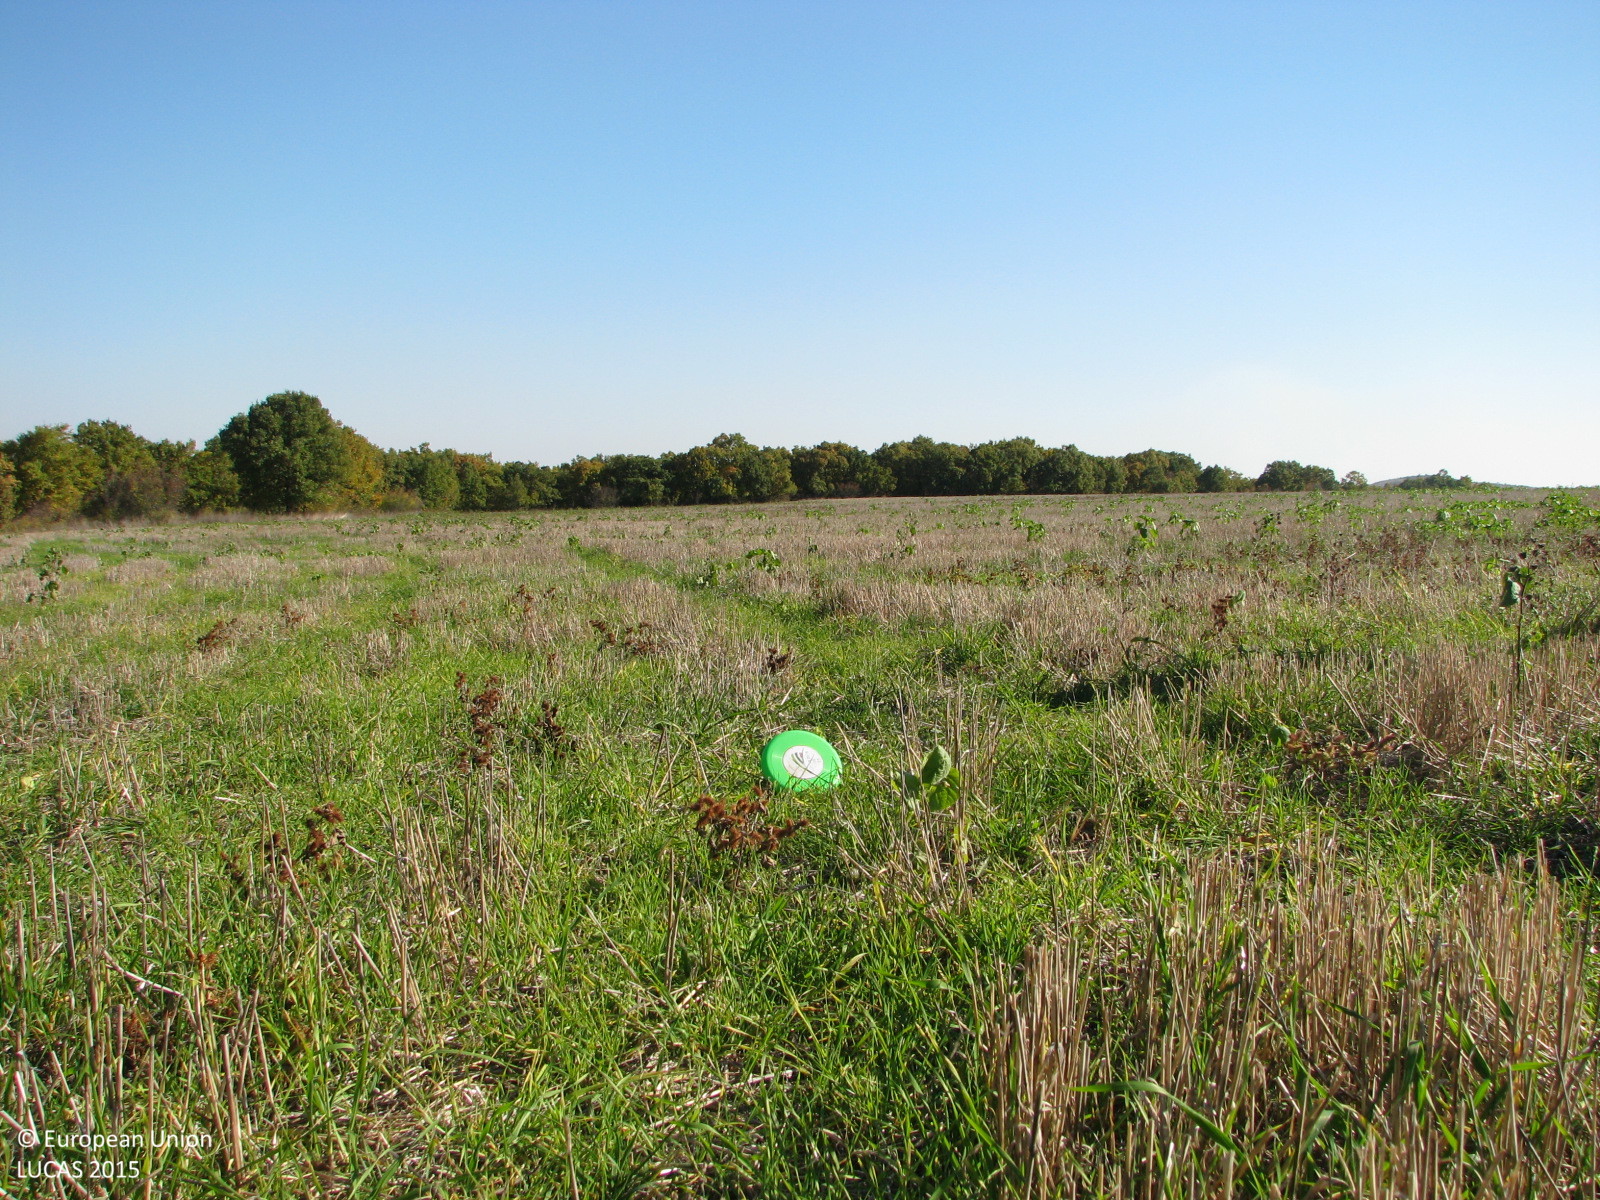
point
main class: Cropland
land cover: Common wheat
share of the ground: 25 - 50 %
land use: Agriculture (excluding fallow land and kitchen gardens)
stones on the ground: < 10 %
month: November
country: BG
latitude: 41.8675
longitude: 26.4559
